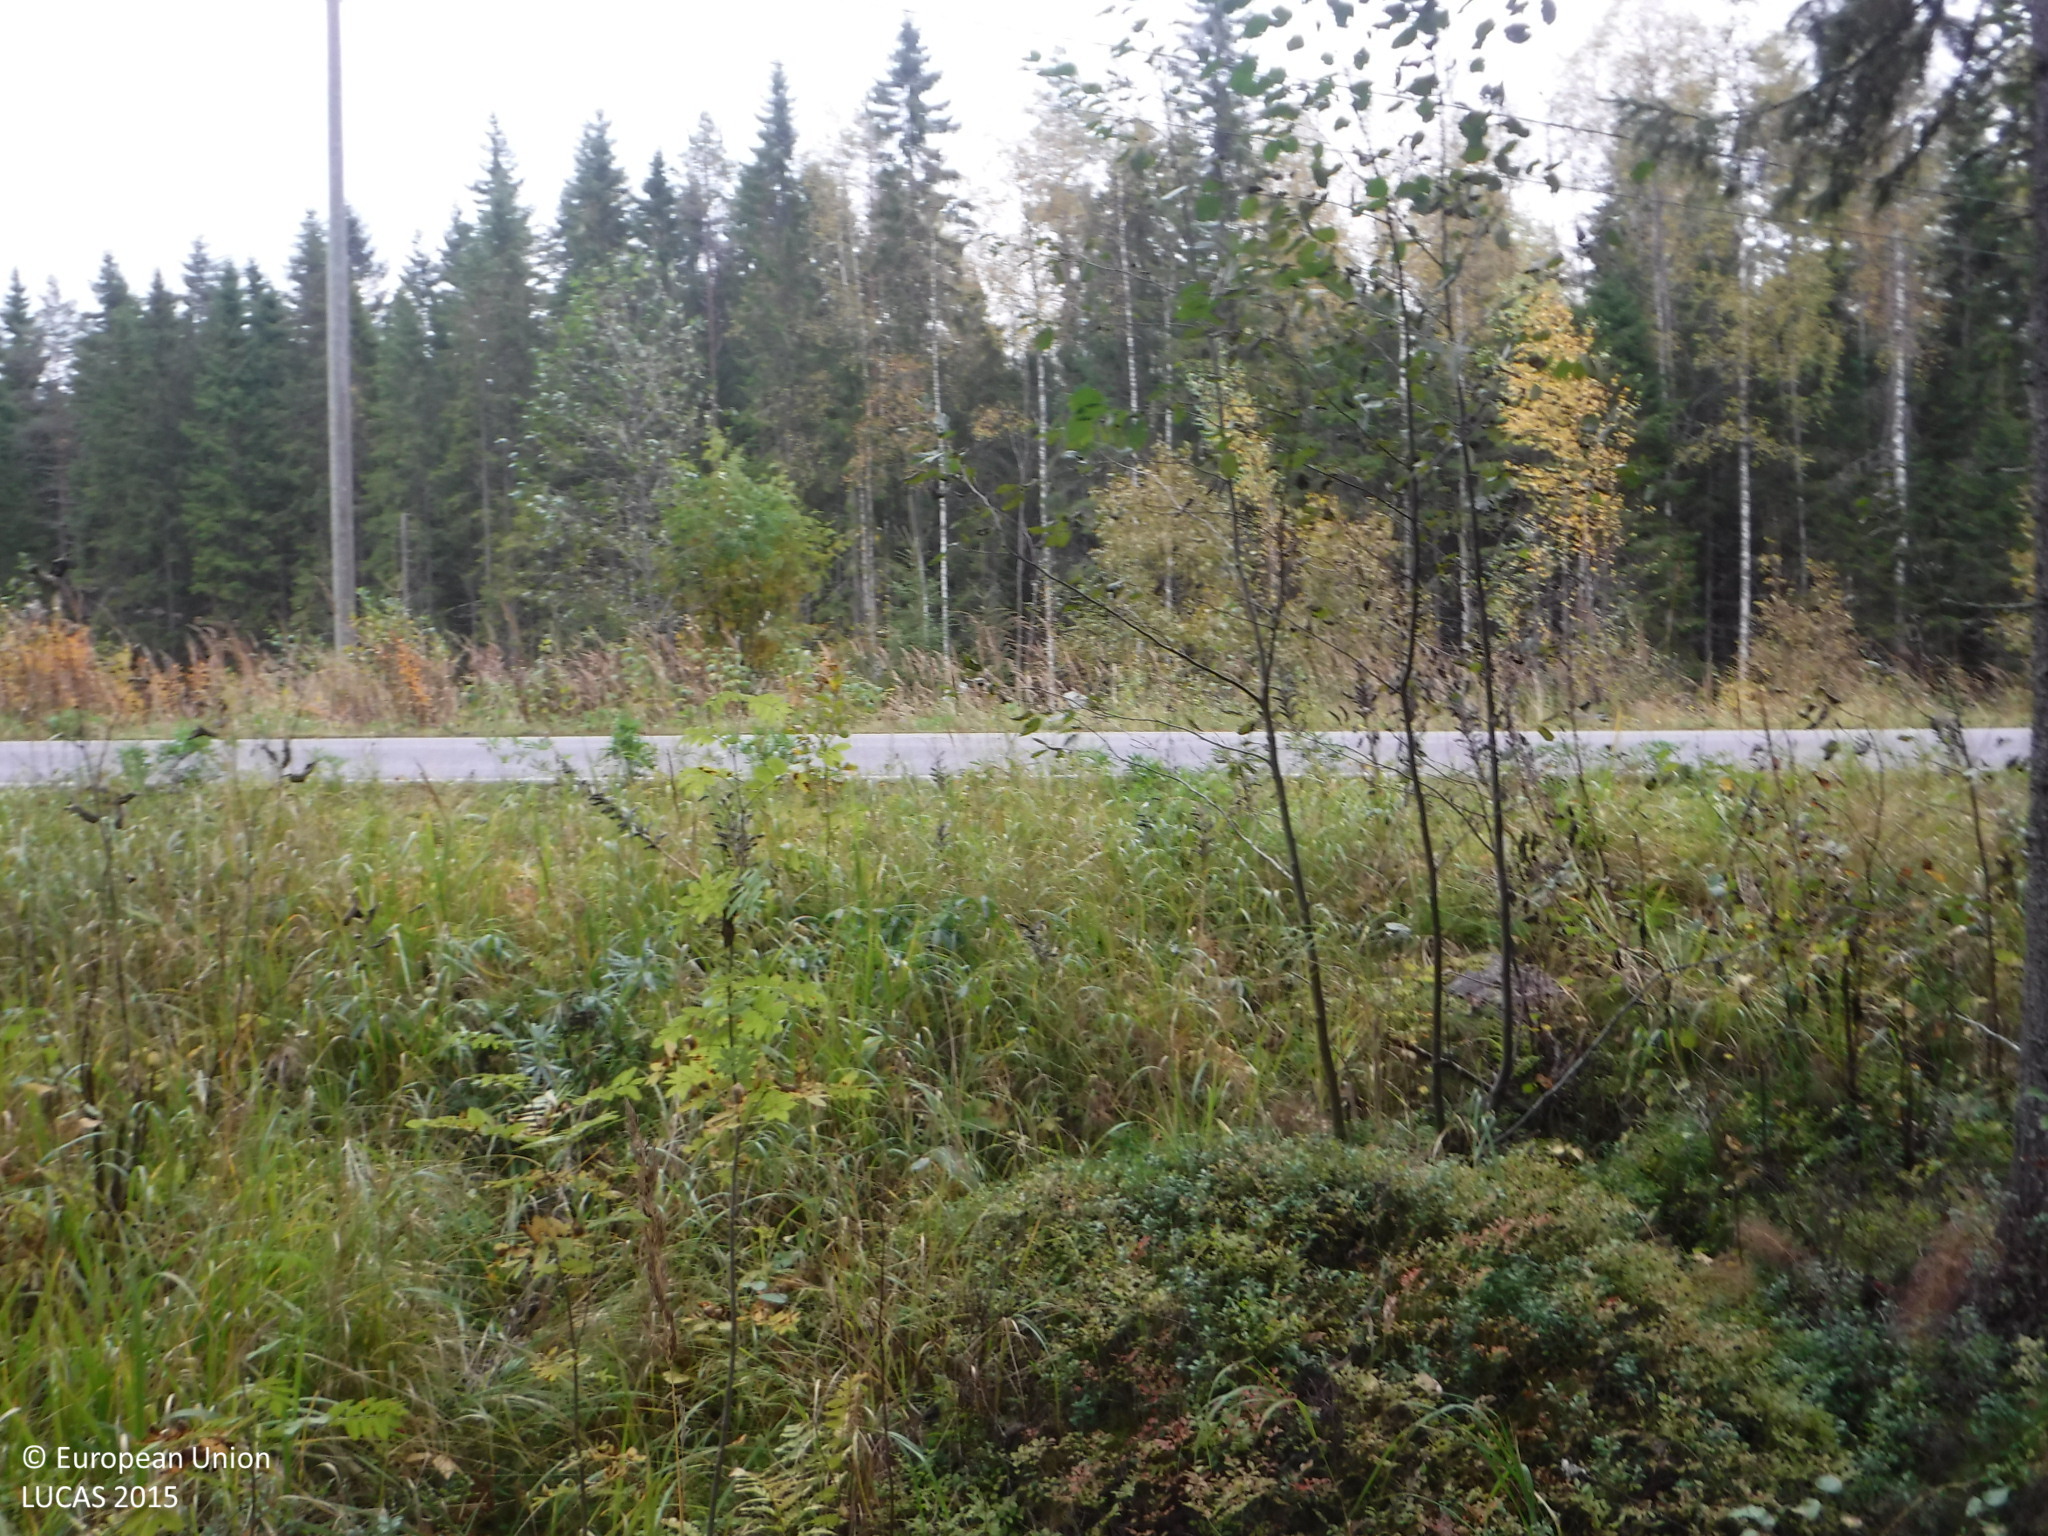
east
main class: Woodland
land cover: Spruce dominated coniferous woodland
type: boreal forest
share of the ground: 50 - 75 %
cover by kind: coniferous forest trees 70 %, shrubs 15 %, lichens and mosses 15 %
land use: Forestry
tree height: > 5 m
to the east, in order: Spruce dominated coniferous woodland; Grass margins; Paved roads, cycling and walking lanes; Grass margins; Shruby margins; Electric lines; Groves; Broadleaved woodland; Spruce dominated mixed woodland; Ditches and canals; Spruce dominated mixed woodland; Ditches and canals; Other mixed woodland; Ditches and canals; Spruce dominated mixed woodland; Ditches and canals
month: September
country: FI
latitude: 62.1237
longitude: 23.3578
